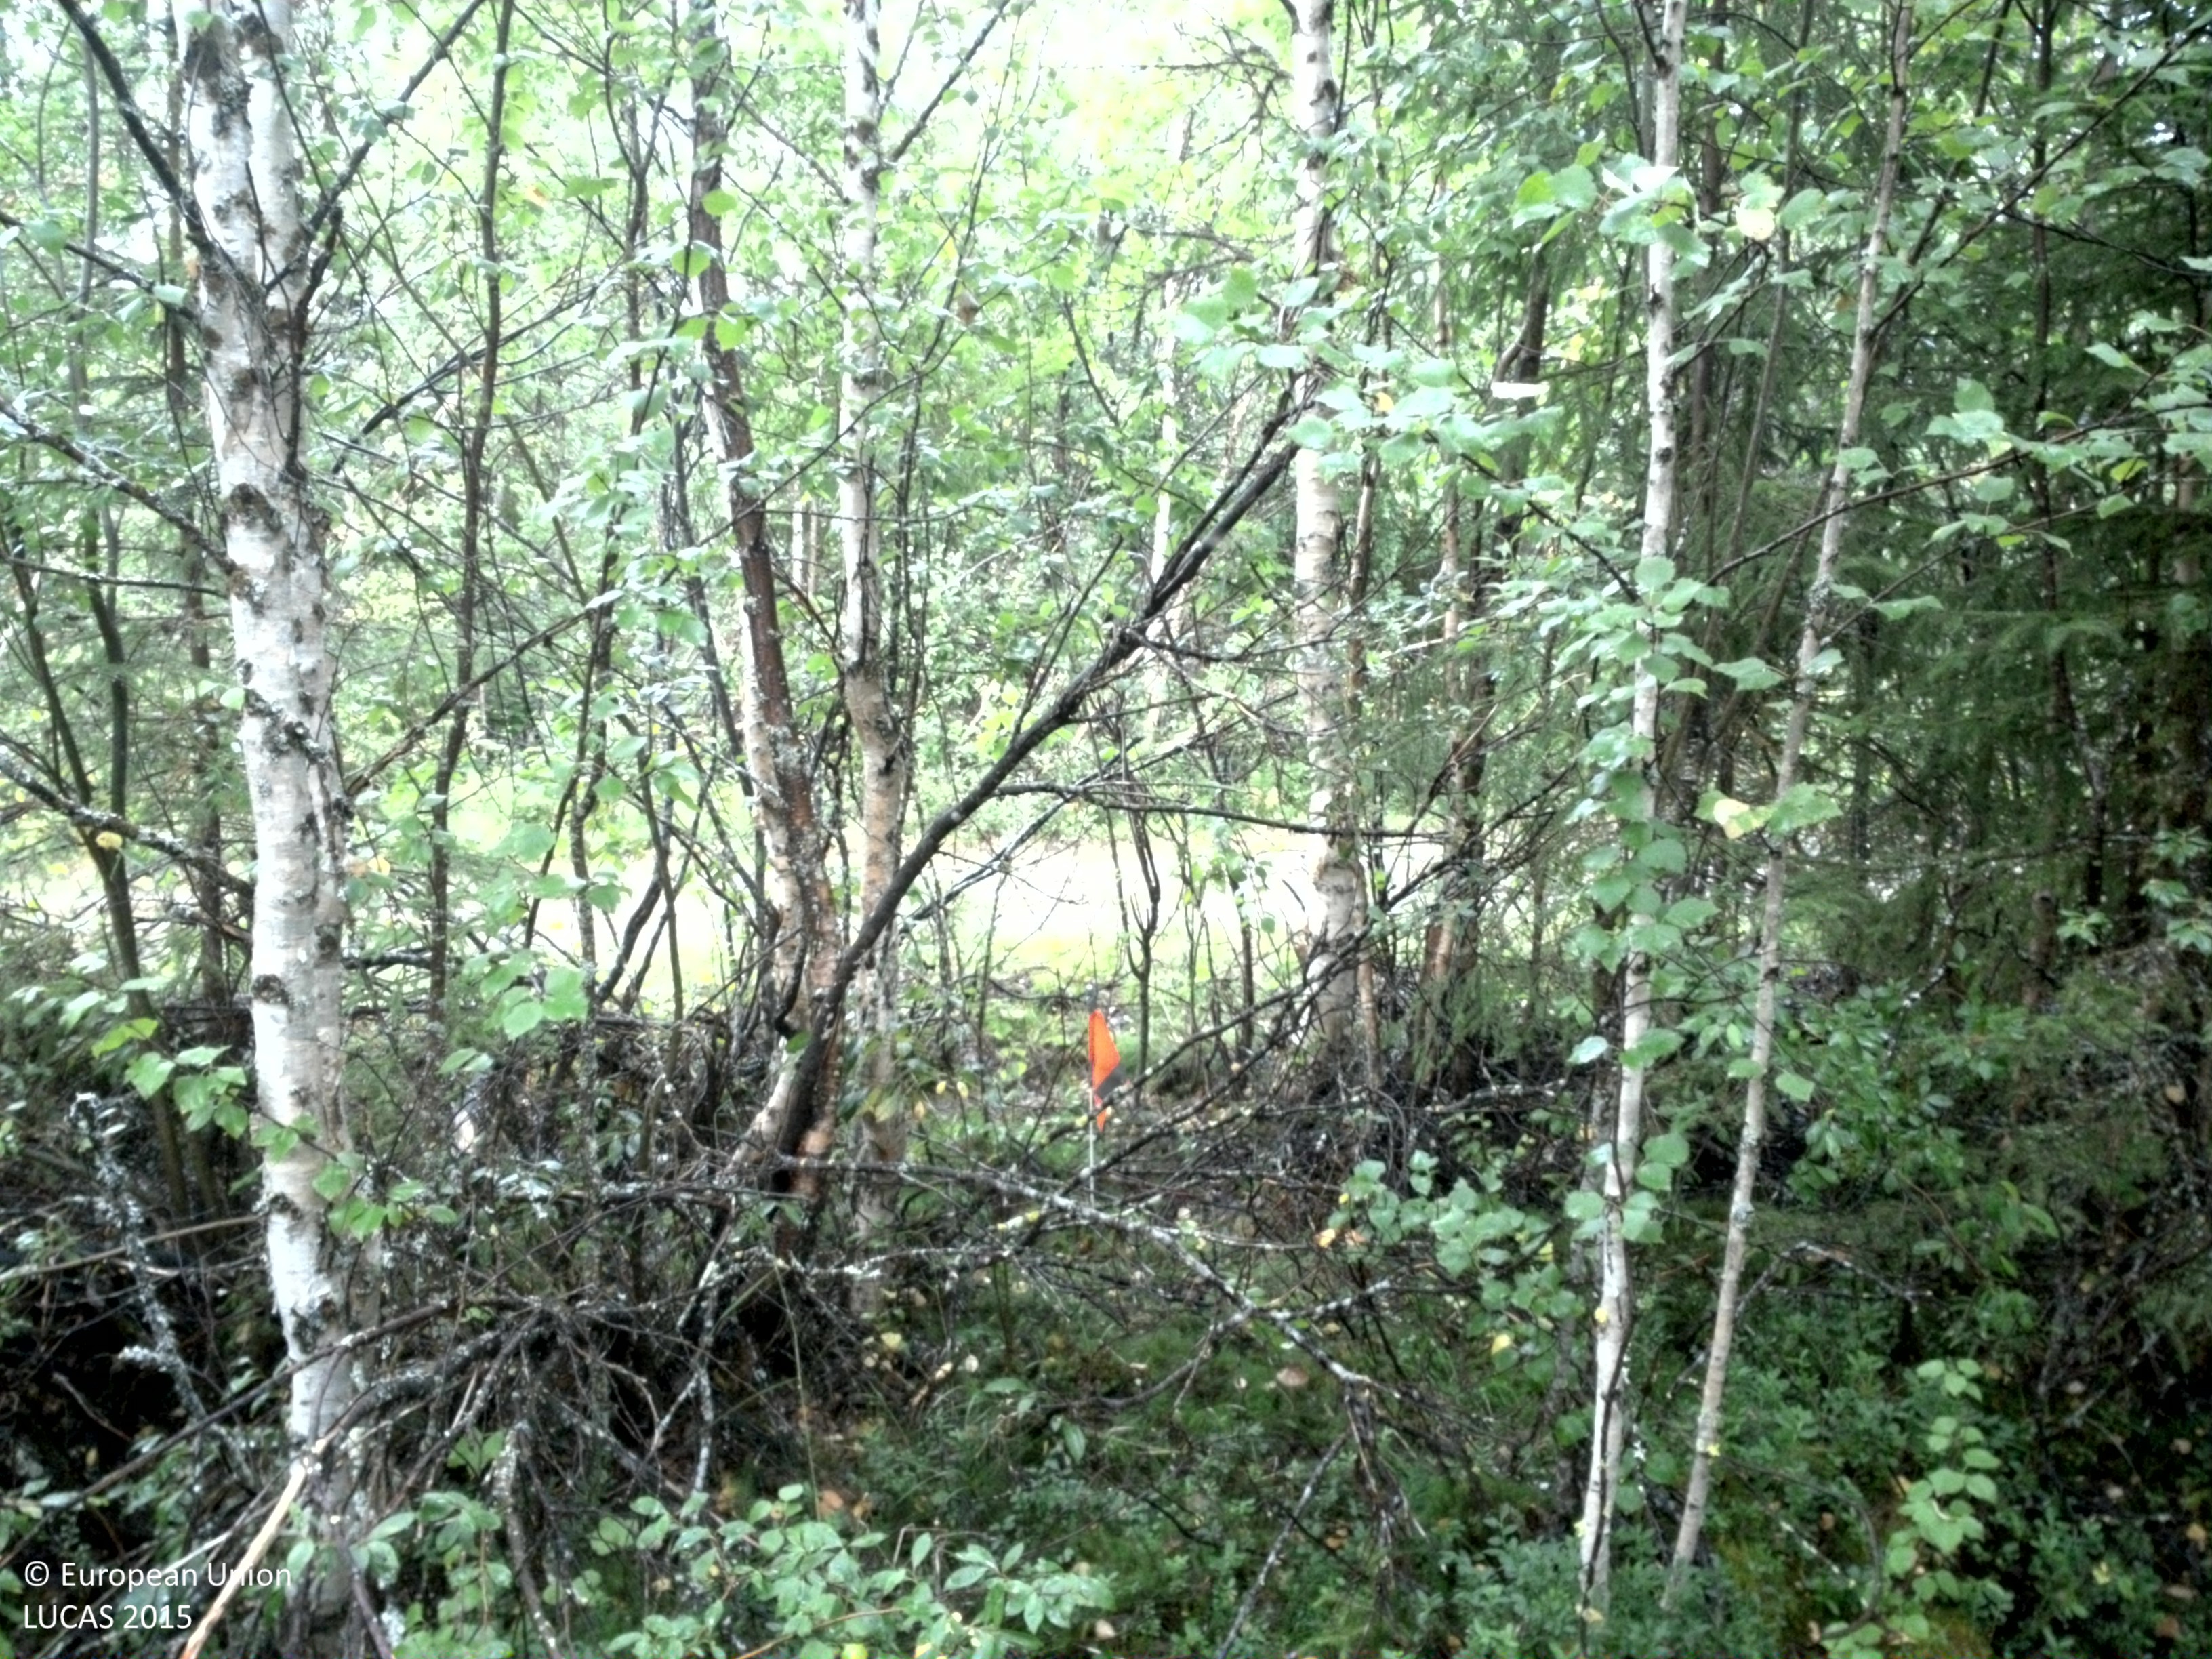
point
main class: Woodland
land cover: Broadleaved woodland
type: non-riverine alder, birch or aspen forest
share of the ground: 50 - 75 %
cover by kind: broadleaved forest trees 60 %, shrubs 15 %, herbaceous plants 10 %, lichens and mosses 10 %, coniferous forest trees 5 %
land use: Forestry
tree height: > 5 m
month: August
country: SE
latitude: 64.8321
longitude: 16.8145
